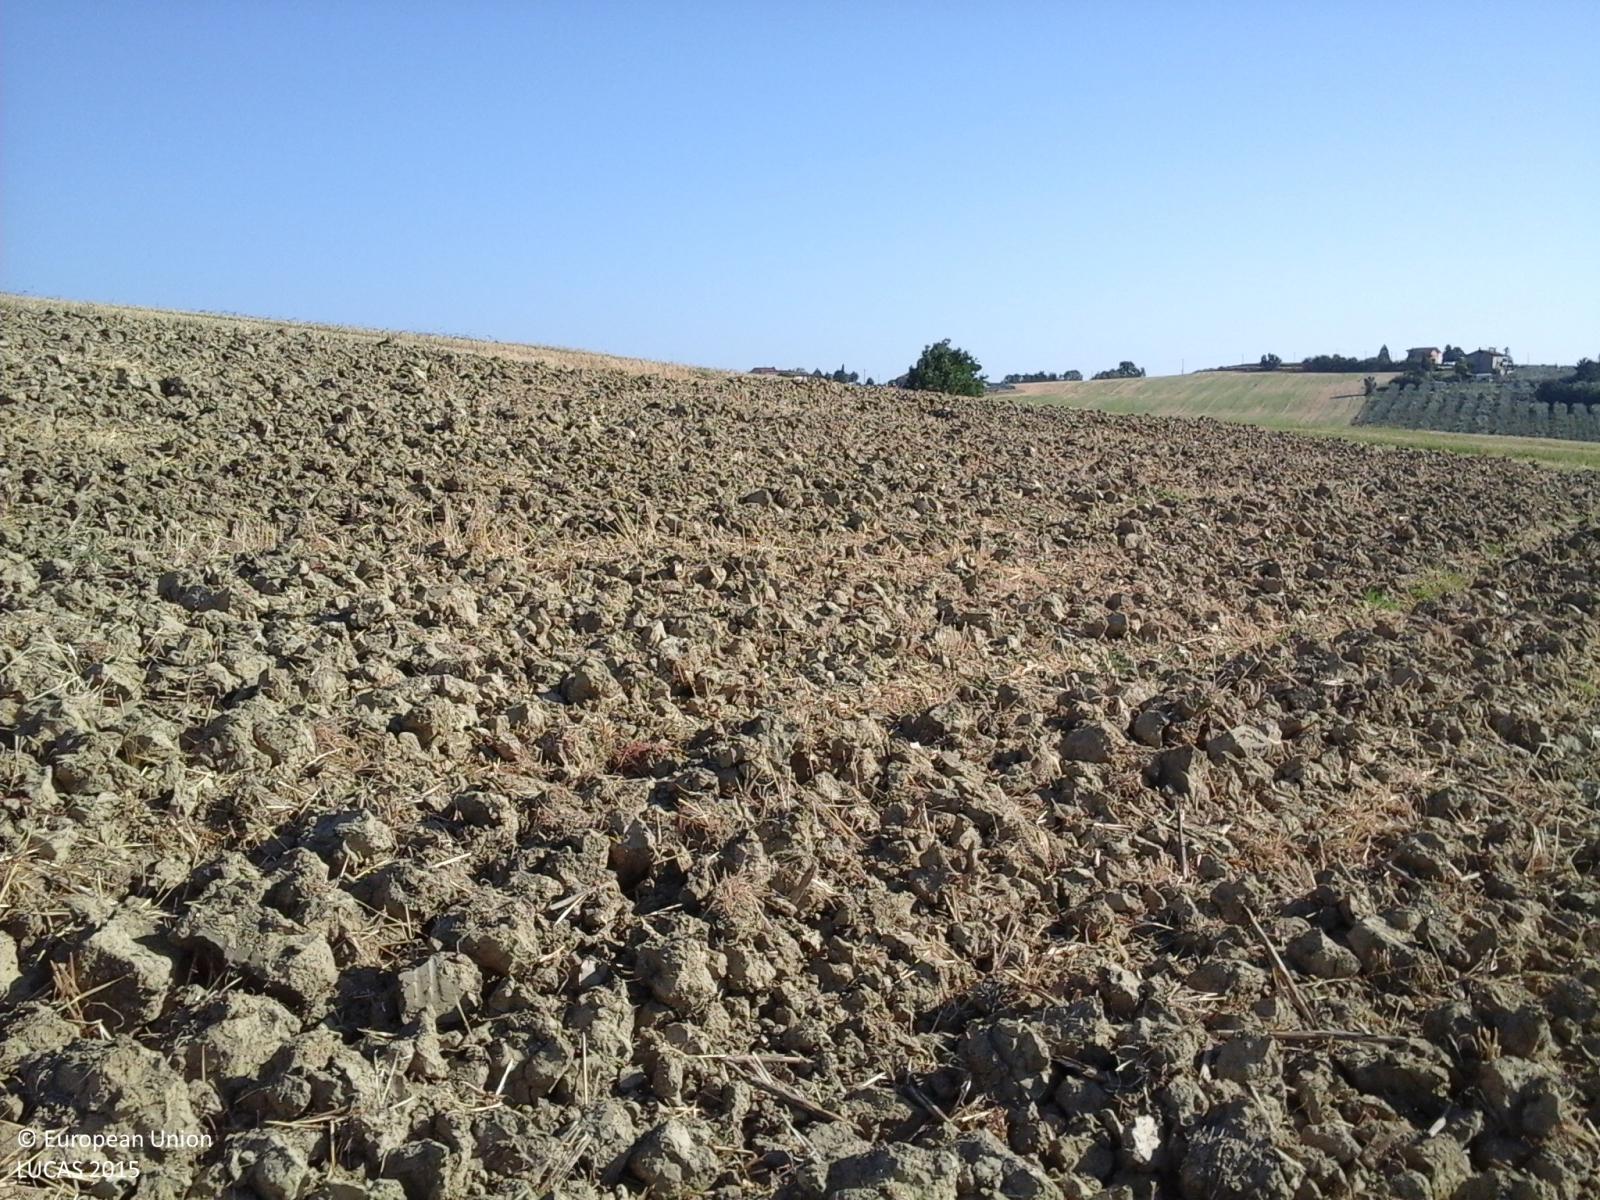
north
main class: Cropland
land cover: Common wheat
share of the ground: < 10 %
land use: Agriculture (excluding fallow land and kitchen gardens)
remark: Harvested field
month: July
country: IT
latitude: 43.9185
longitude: 12.6962
